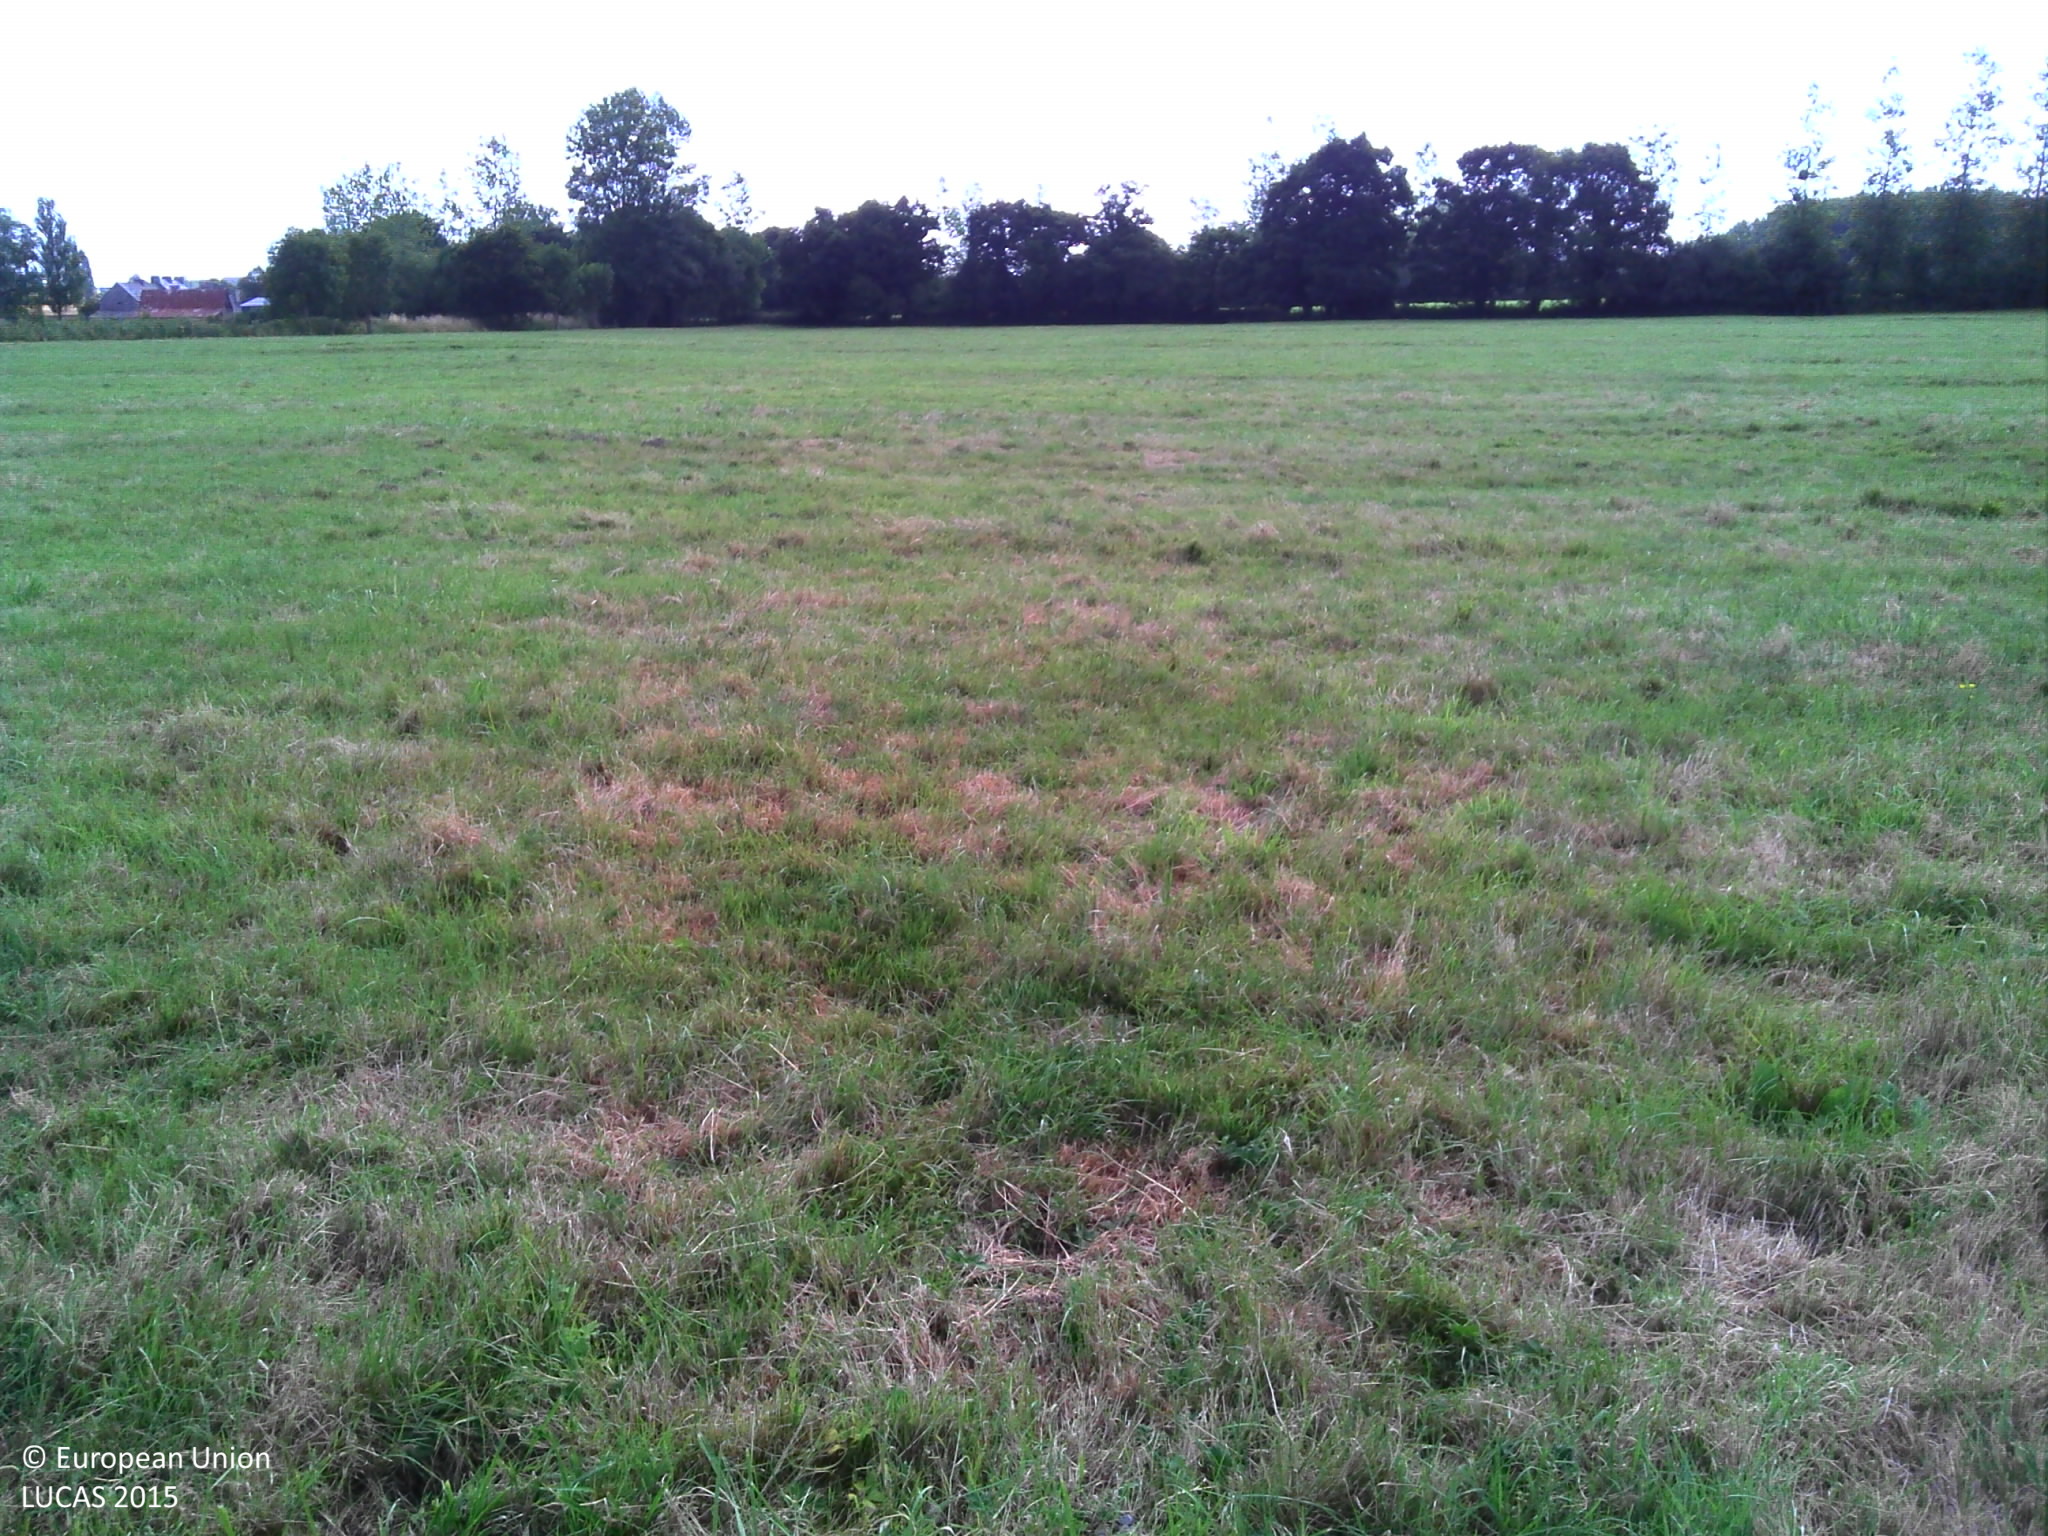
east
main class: Grassland
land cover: Grassland without tree/shrub cover
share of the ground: > 75 %
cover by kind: herbaceous plants 95 %, unconsolidated bare surface 5 %
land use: Agriculture (excluding fallow land and kitchen gardens)
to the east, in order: Grassland without tree/shrub cover; Fences; Lines of trees; Grassland without tree/shrub cover
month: July
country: FR
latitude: 48.5666
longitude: -2.1581
